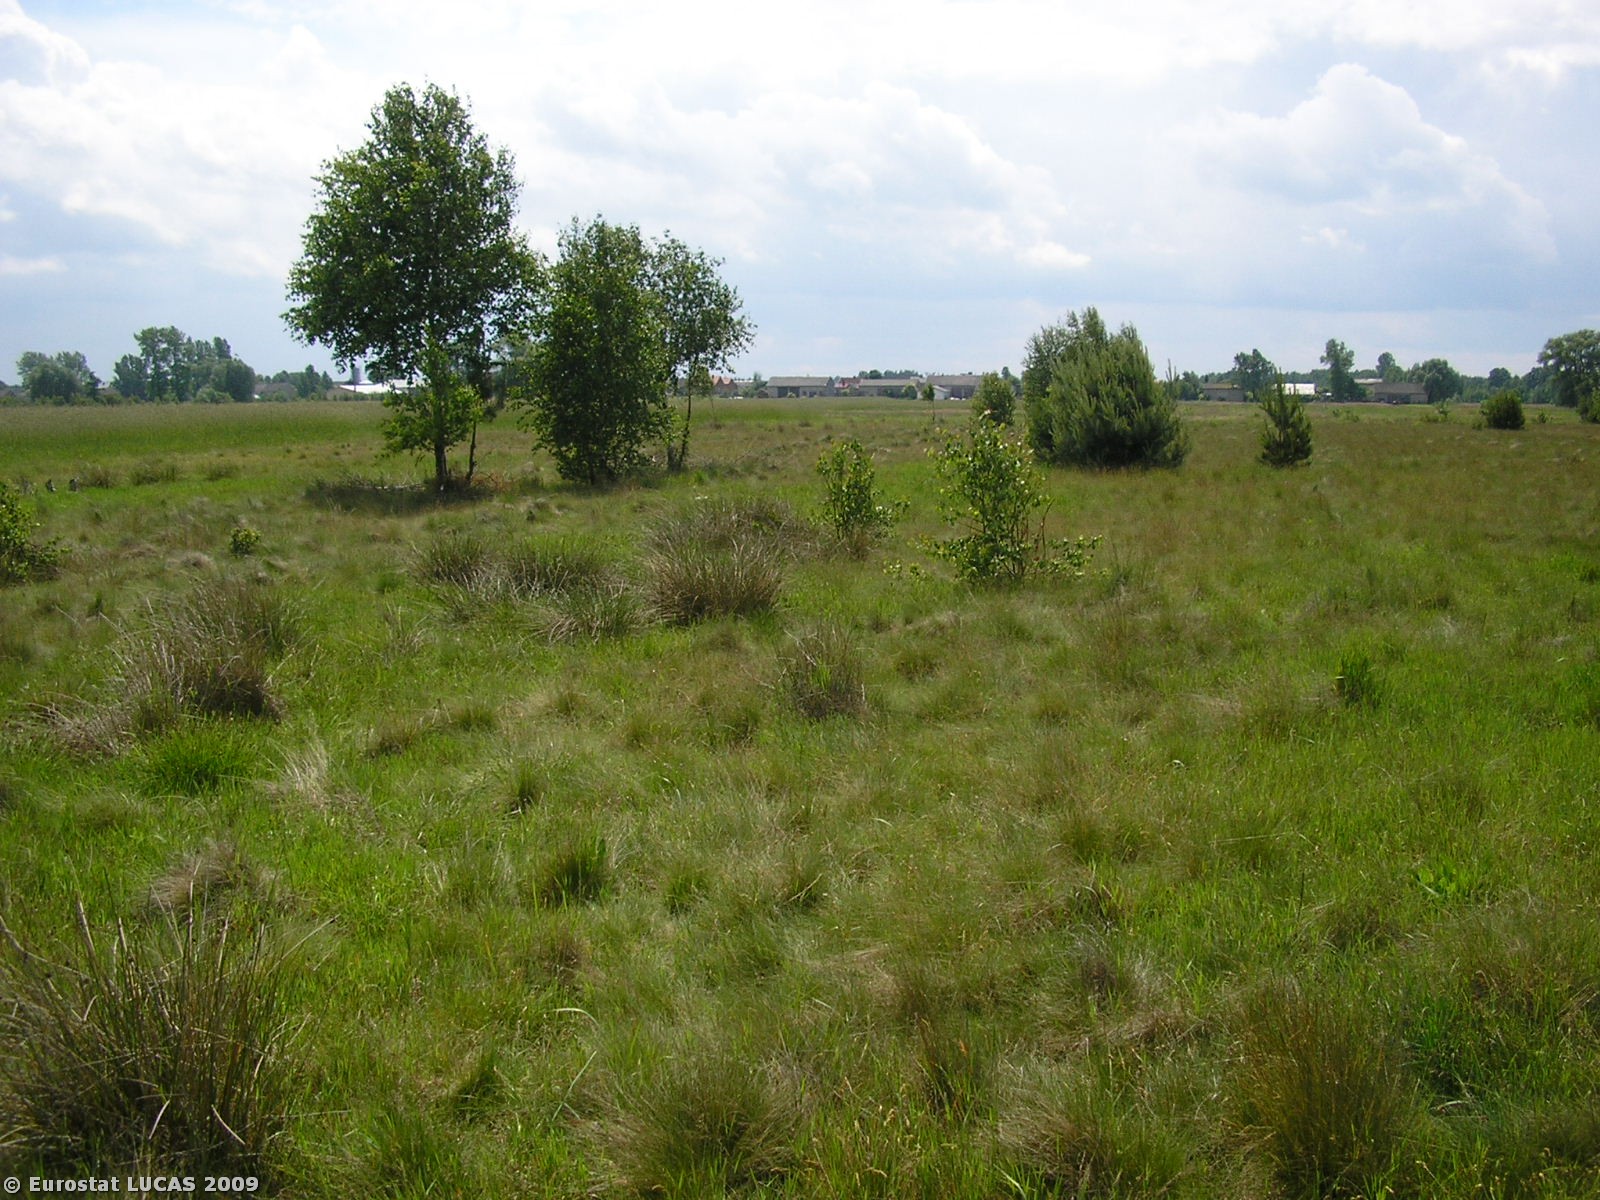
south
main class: Grassland
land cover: Grassland without tree/shrub cover
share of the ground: > 75 %
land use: Fallow land
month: June
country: PL
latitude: 51.4057
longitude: 18.9503
